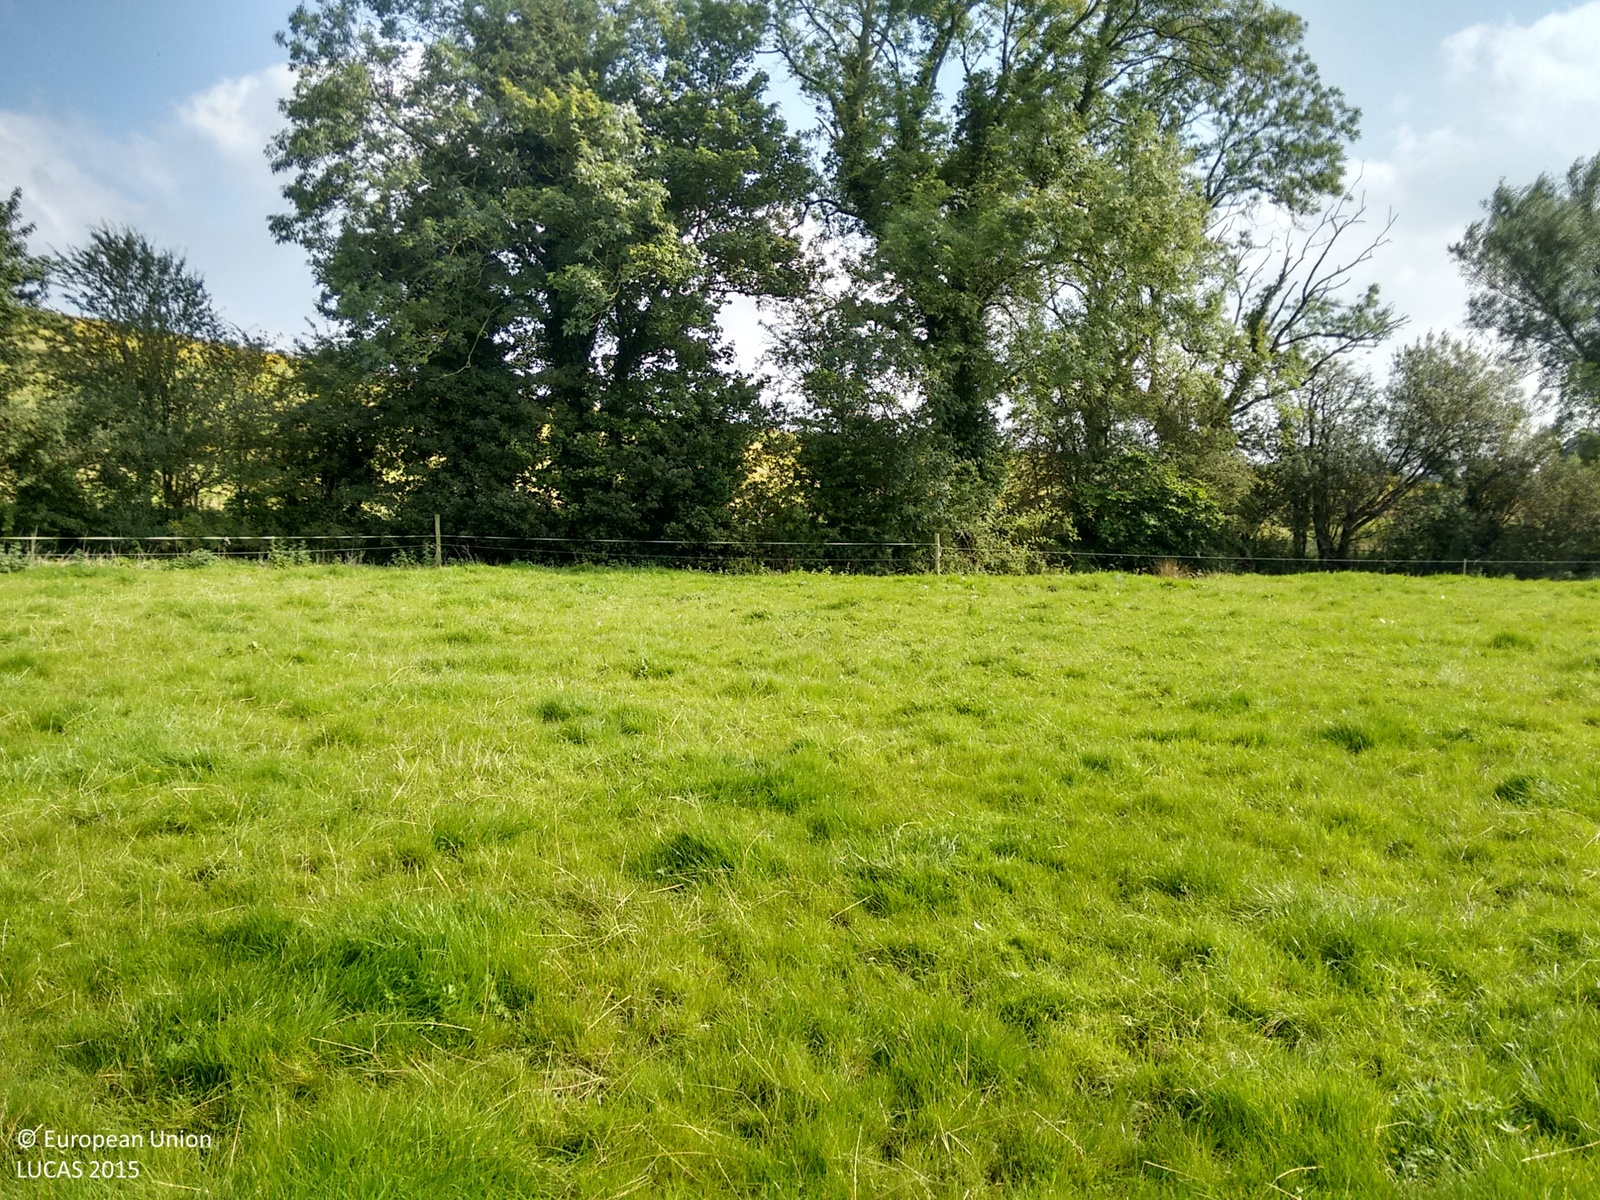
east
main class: Grassland
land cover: Grassland without tree/shrub cover
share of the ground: > 75 %
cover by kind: herbaceous plants 100 %
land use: Agriculture (excluding fallow land and kitchen gardens)
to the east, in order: Grassland without tree/shrub cover; Managed hedges; Rivers and streams; Managed hedges; Grassland without tree/shrub cover
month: September
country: IE
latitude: 54.2690
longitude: -6.9840
